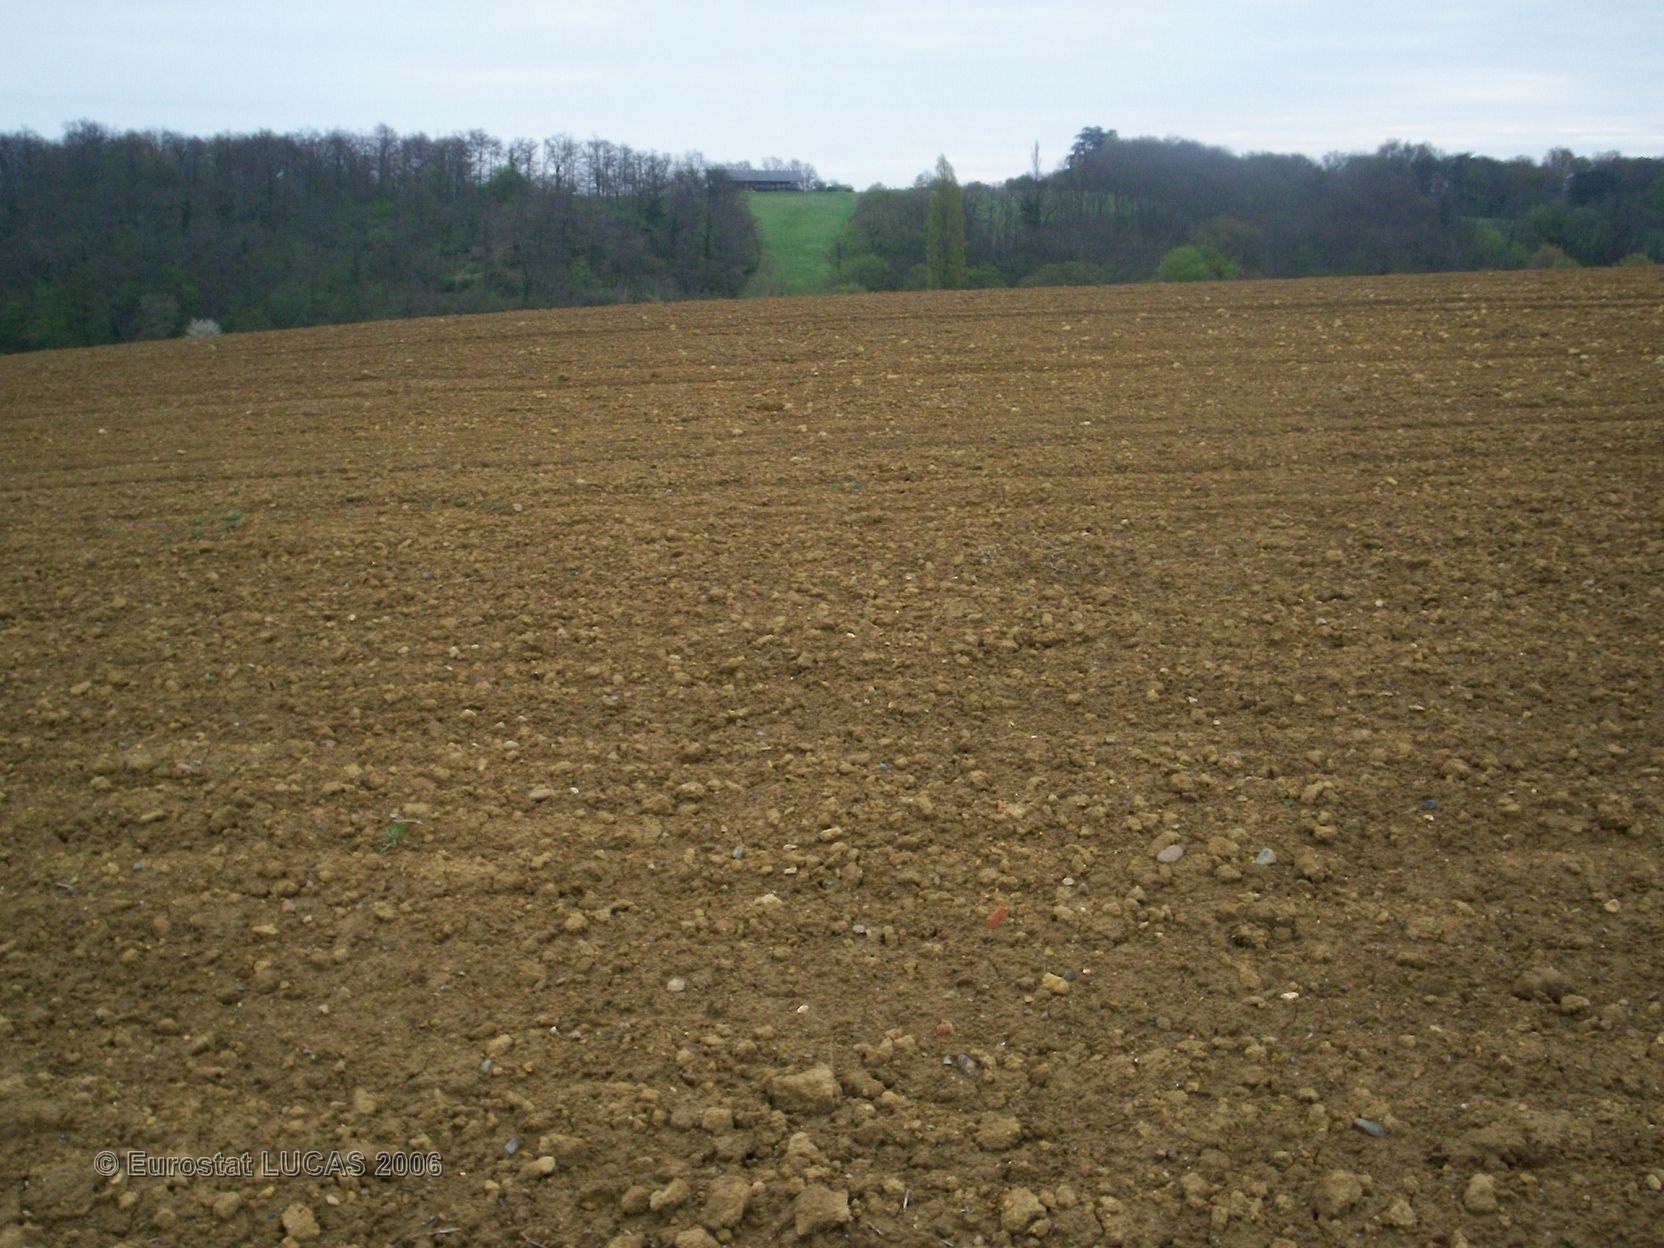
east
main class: Cropland
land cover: Maize
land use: Agriculture (excluding fallow land and kitchen gardens)
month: June
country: FR
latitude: 43.5684
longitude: 0.3016
